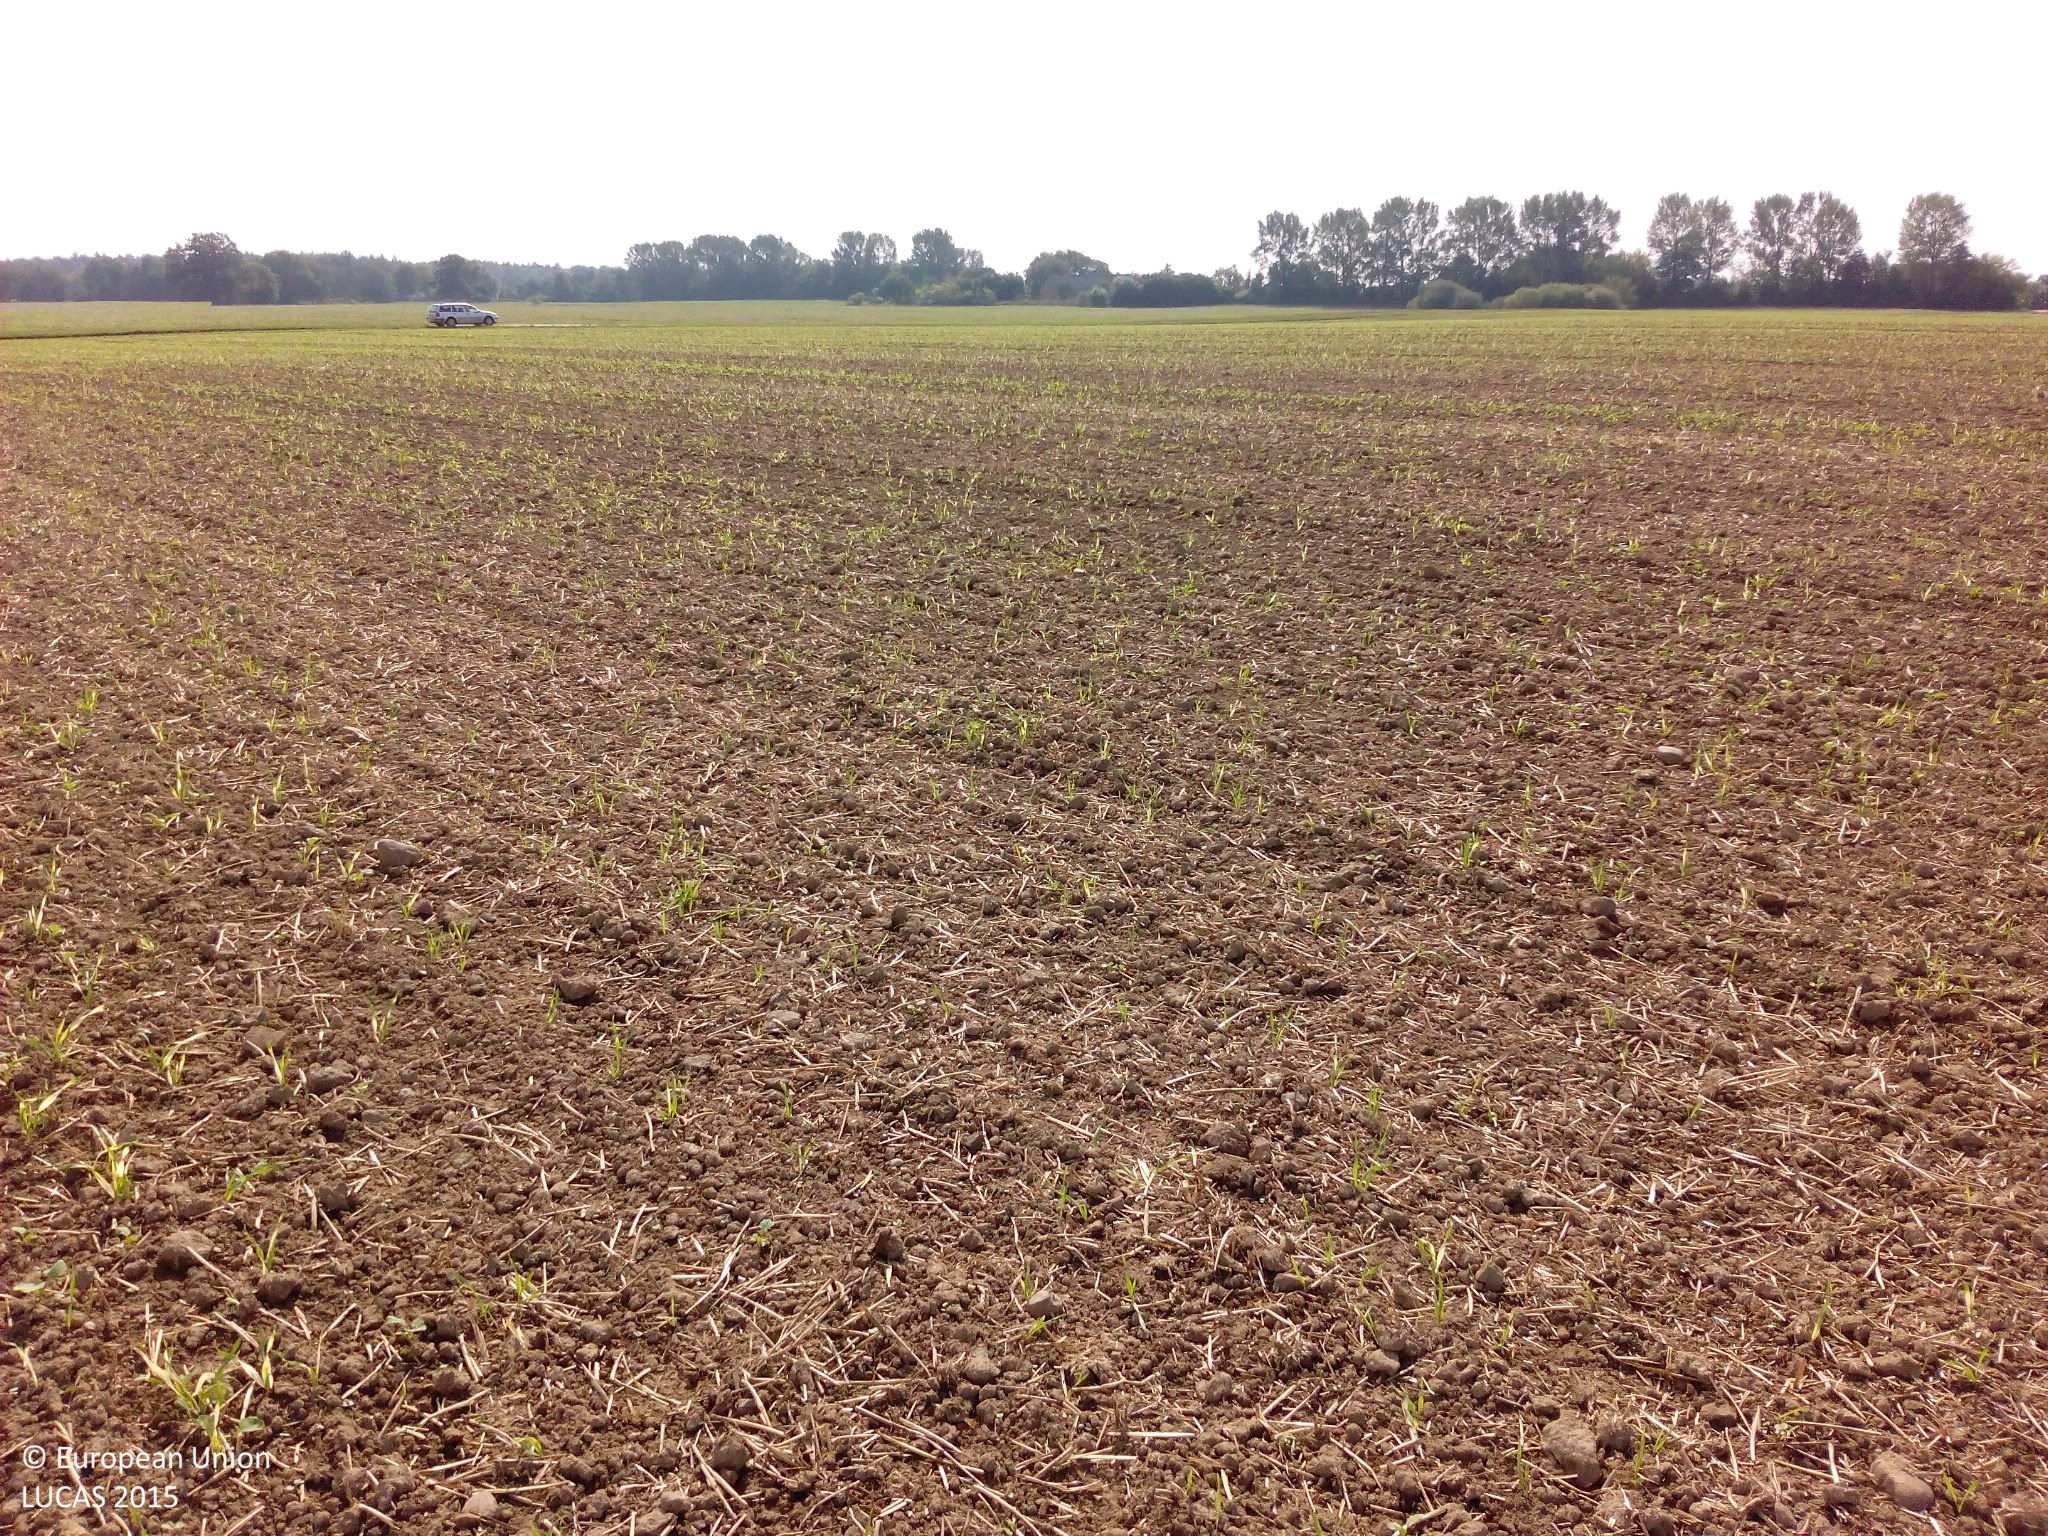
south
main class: Cropland
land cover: Rape and turnip rape
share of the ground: < 10 %
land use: Agriculture (excluding fallow land and kitchen gardens)
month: August
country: DE
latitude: 54.2367
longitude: 12.6226
